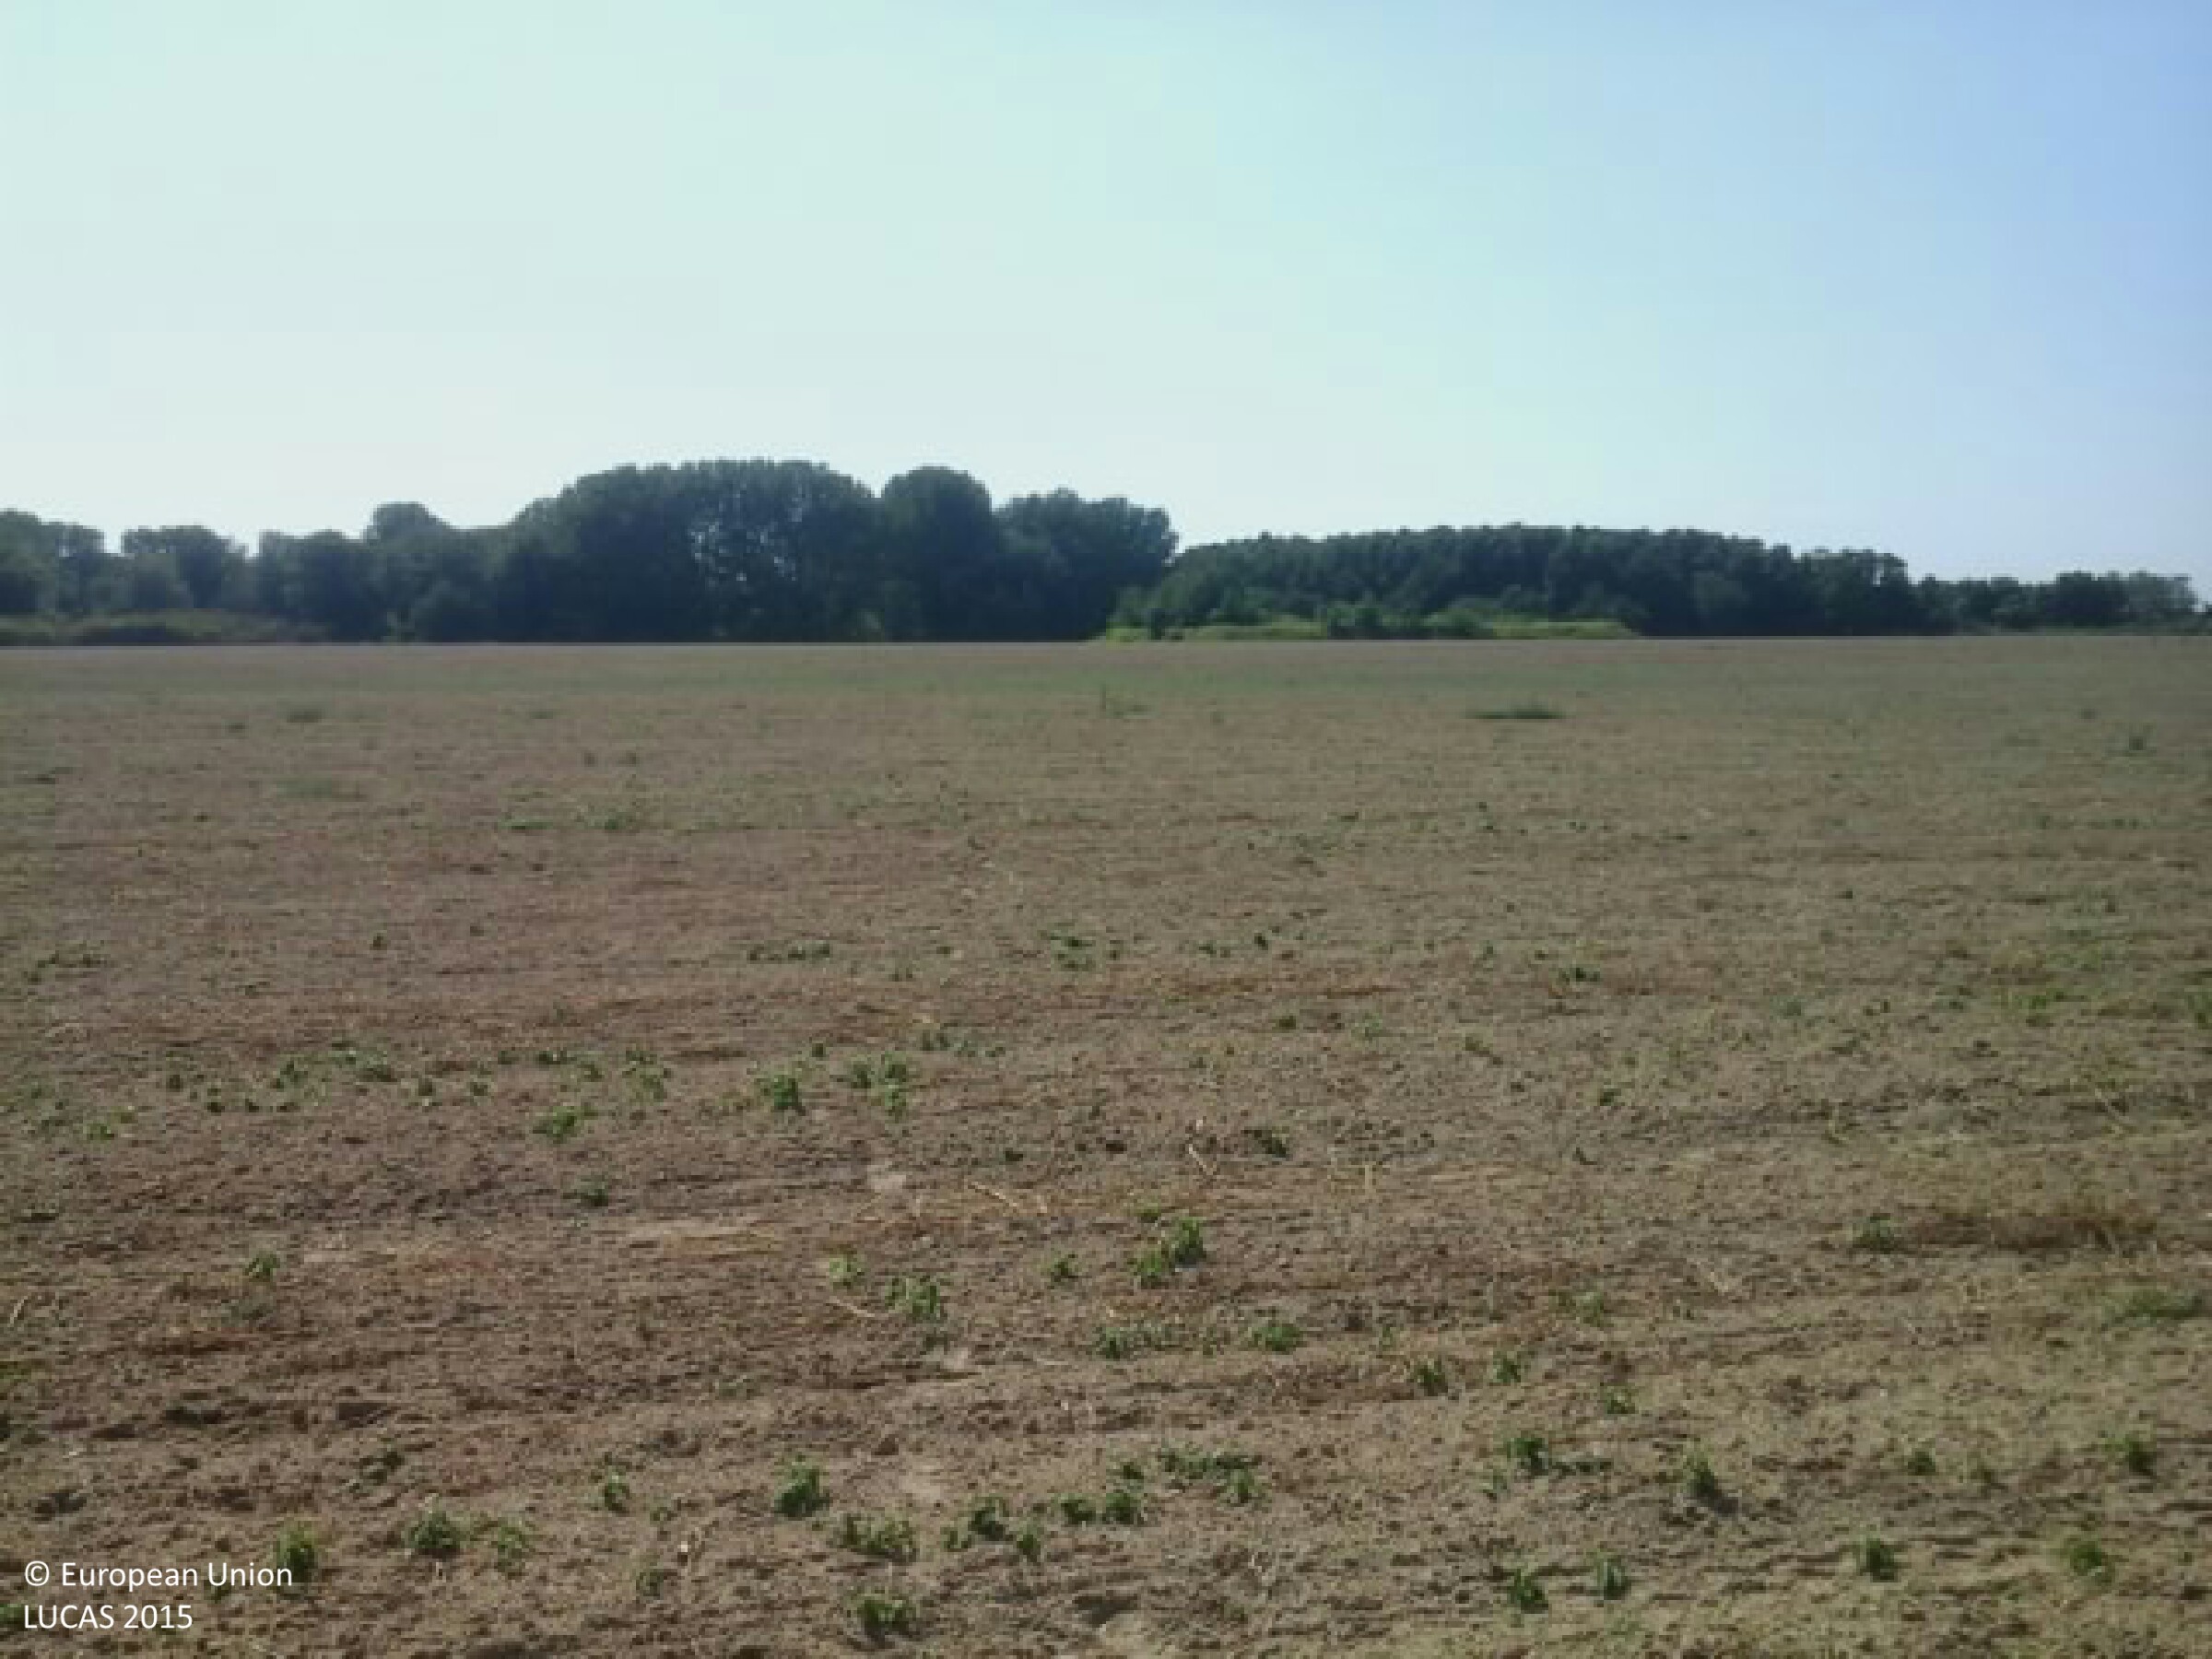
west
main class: Grassland
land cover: Spontaneously vegetated surfaces
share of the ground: 10 - 25 %
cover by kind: unconsolidated bare surface 90 %, herbaceous plants 10 %
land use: Fallow land
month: July
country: HU
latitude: 46.2188
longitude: 17.1715
